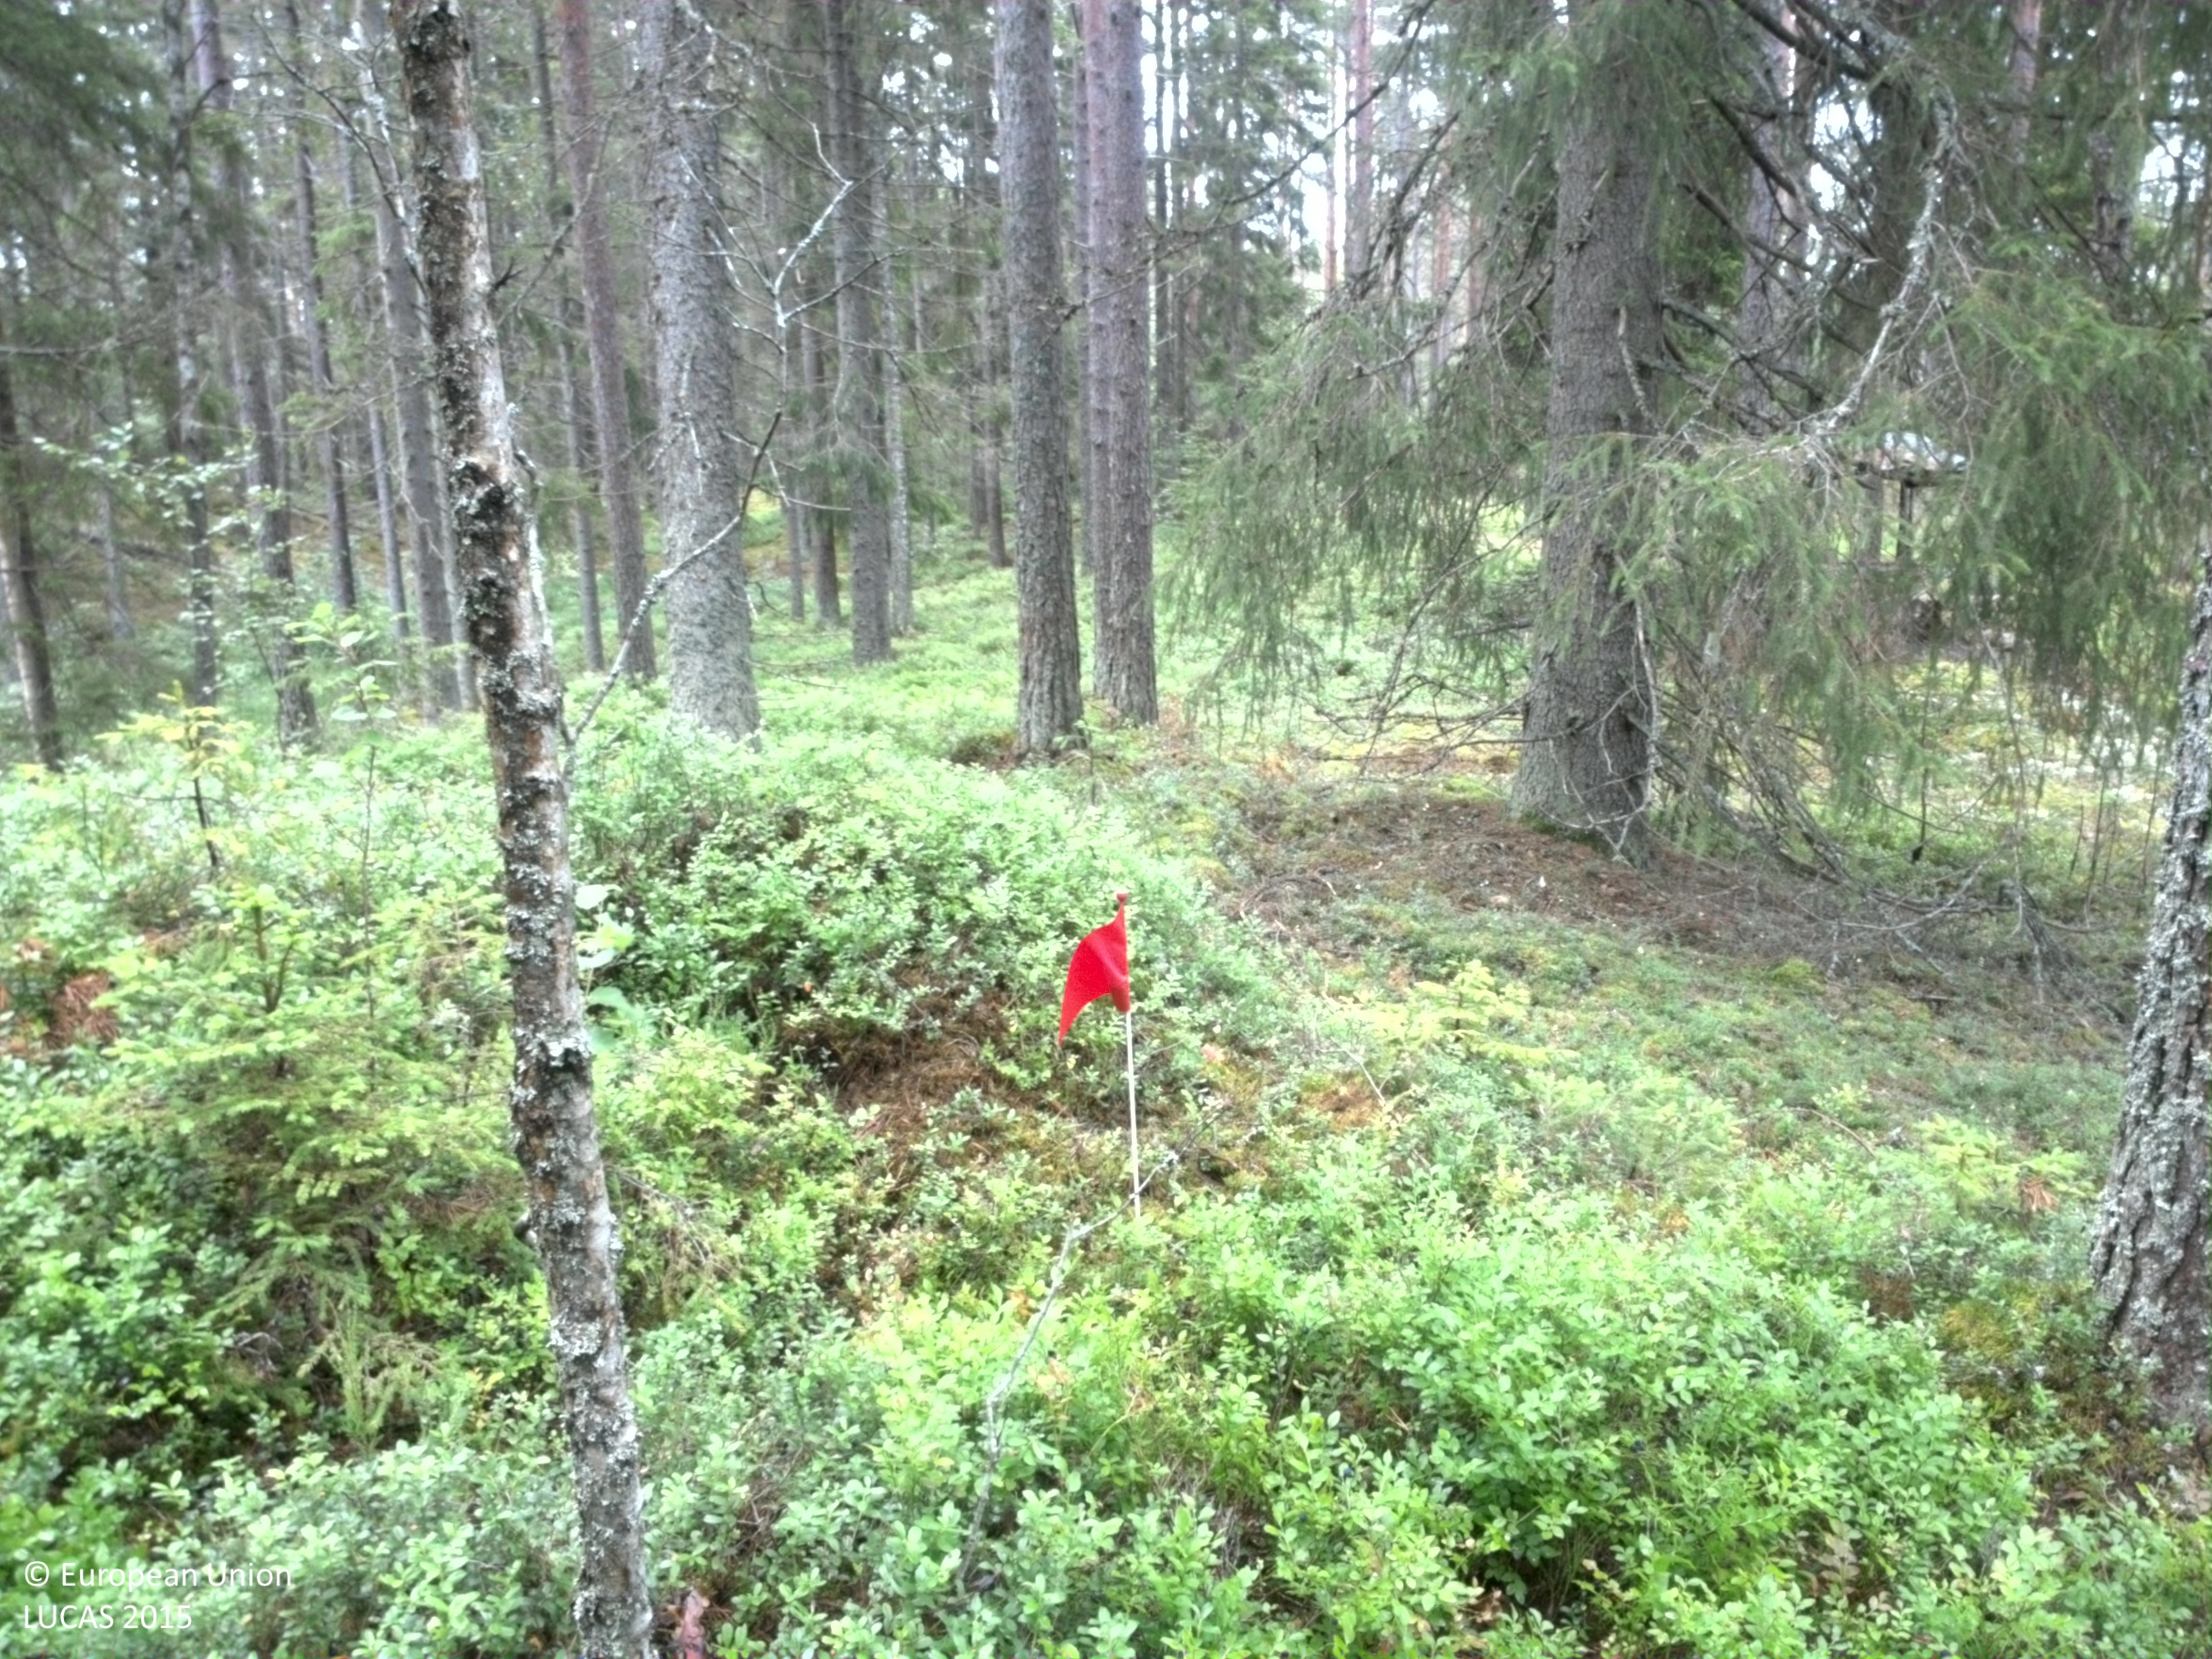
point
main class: Woodland
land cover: Spruce dominated coniferous woodland
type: boreal forest
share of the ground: 50 - 75 %
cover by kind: coniferous forest trees 65 %, shrubs 20 %, lichens and mosses 10 %, broadleaved forest trees 5 %
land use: Forestry
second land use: Amenities, museums, leisure
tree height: > 5 m
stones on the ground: 25 - 50 %
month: July
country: SE
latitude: 59.4030
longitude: 13.3213
